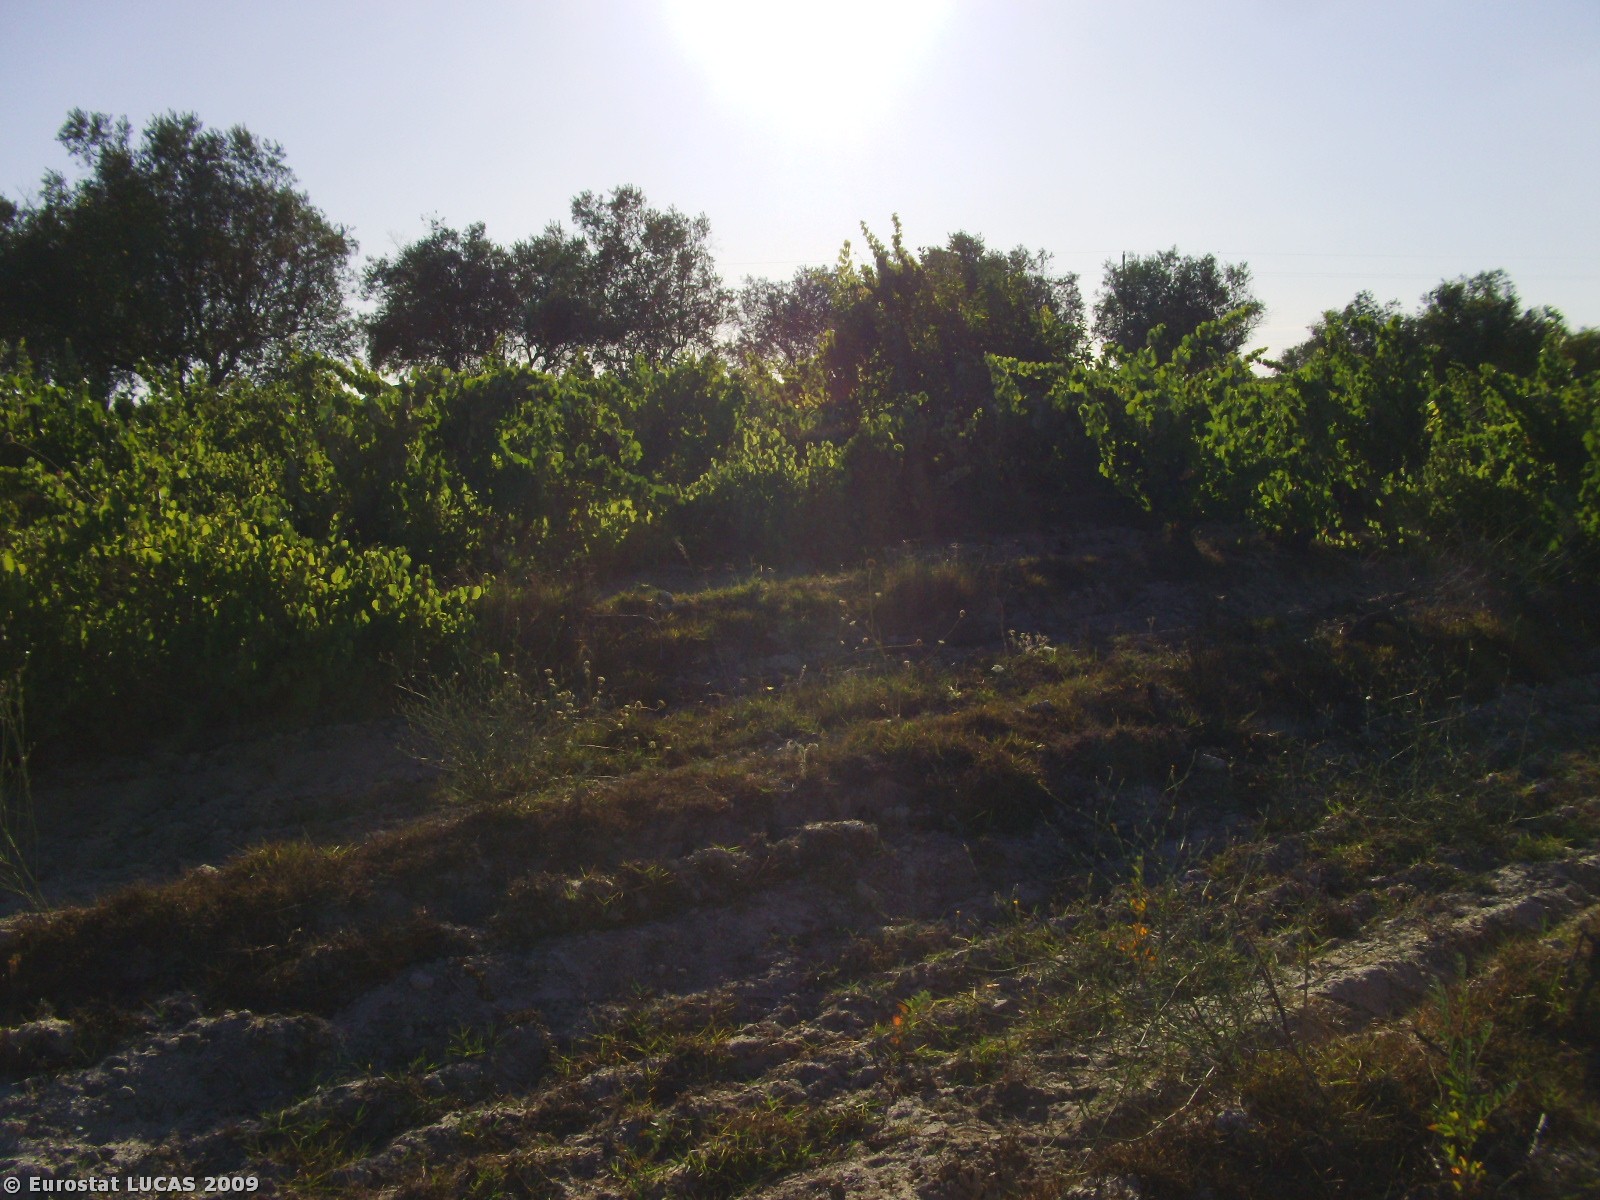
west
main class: Cropland
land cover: Vineyards
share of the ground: 25 - 50 %
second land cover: Bare land
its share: 25 - 50 %
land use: Agriculture (excluding fallow land and kitchen gardens)
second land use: Fallow land
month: August
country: PT
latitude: 38.6220
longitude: -8.6788
